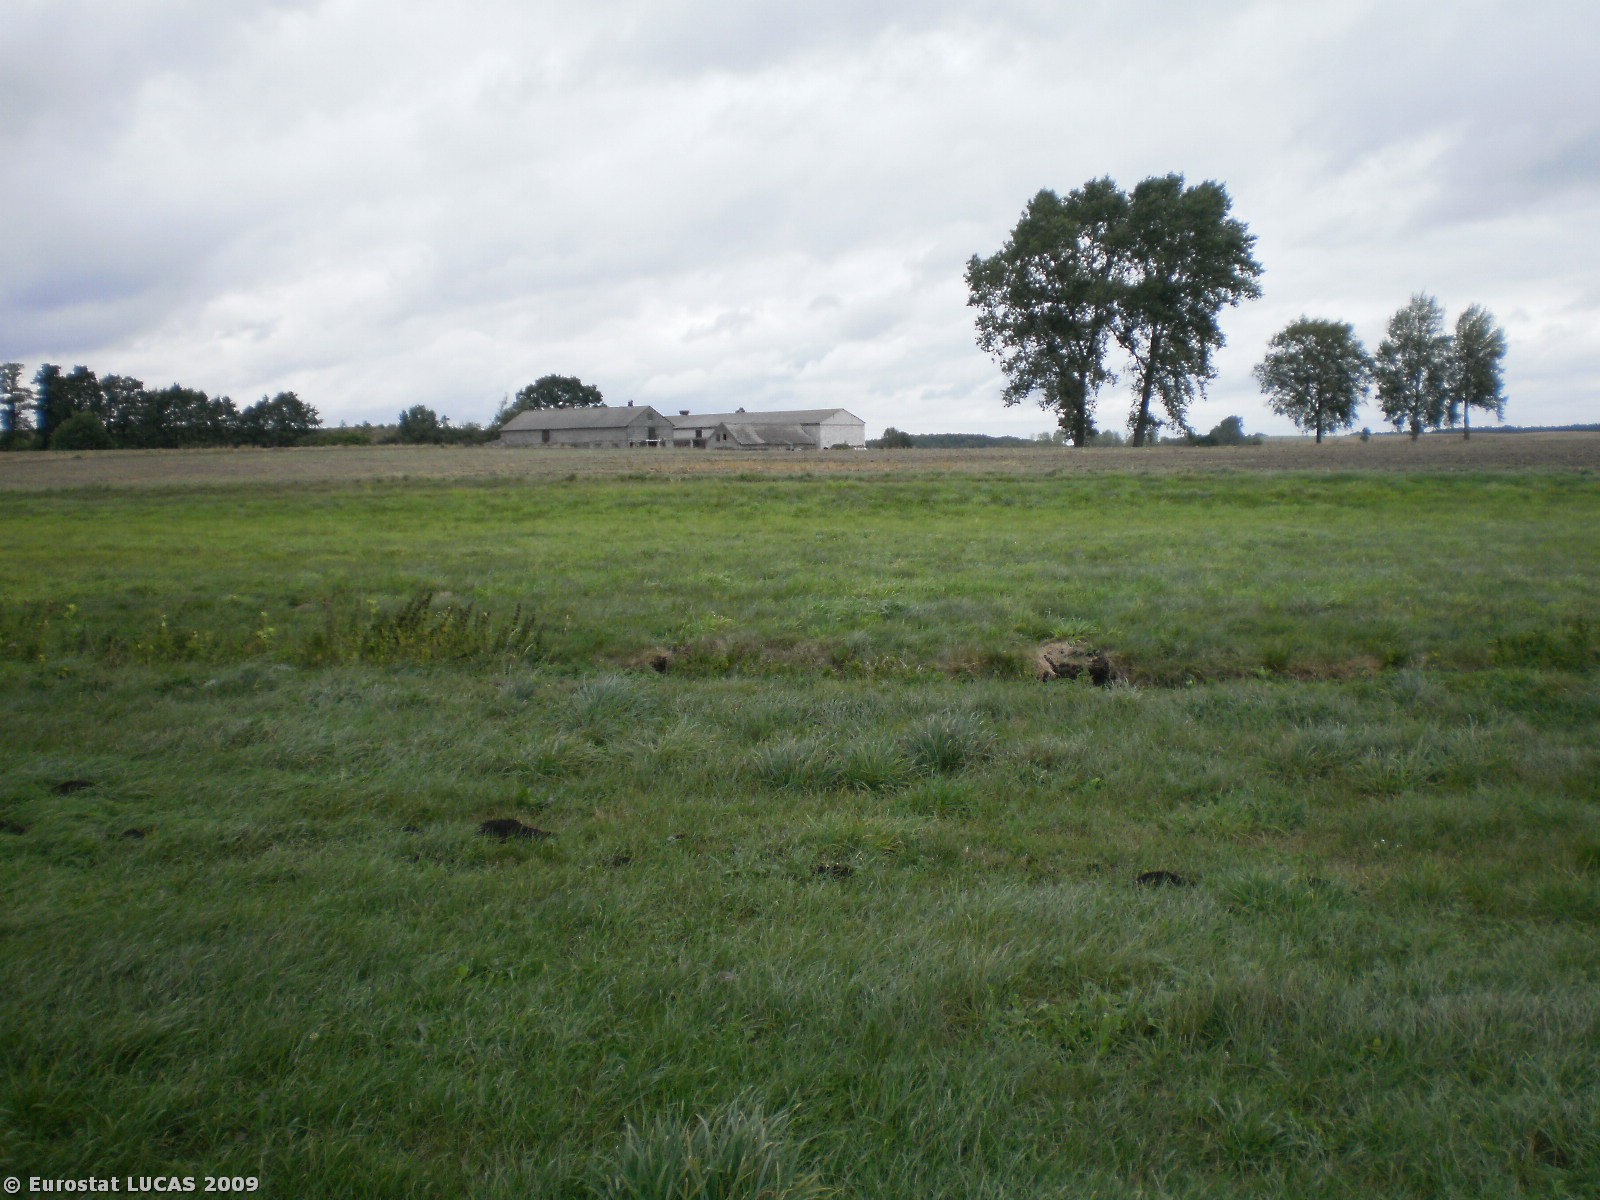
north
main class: Grassland
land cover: Grassland without tree/shrub cover
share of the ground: > 75 %
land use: Agriculture (excluding fallow land and kitchen gardens)
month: September
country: PL
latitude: 53.5899
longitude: 17.7025
